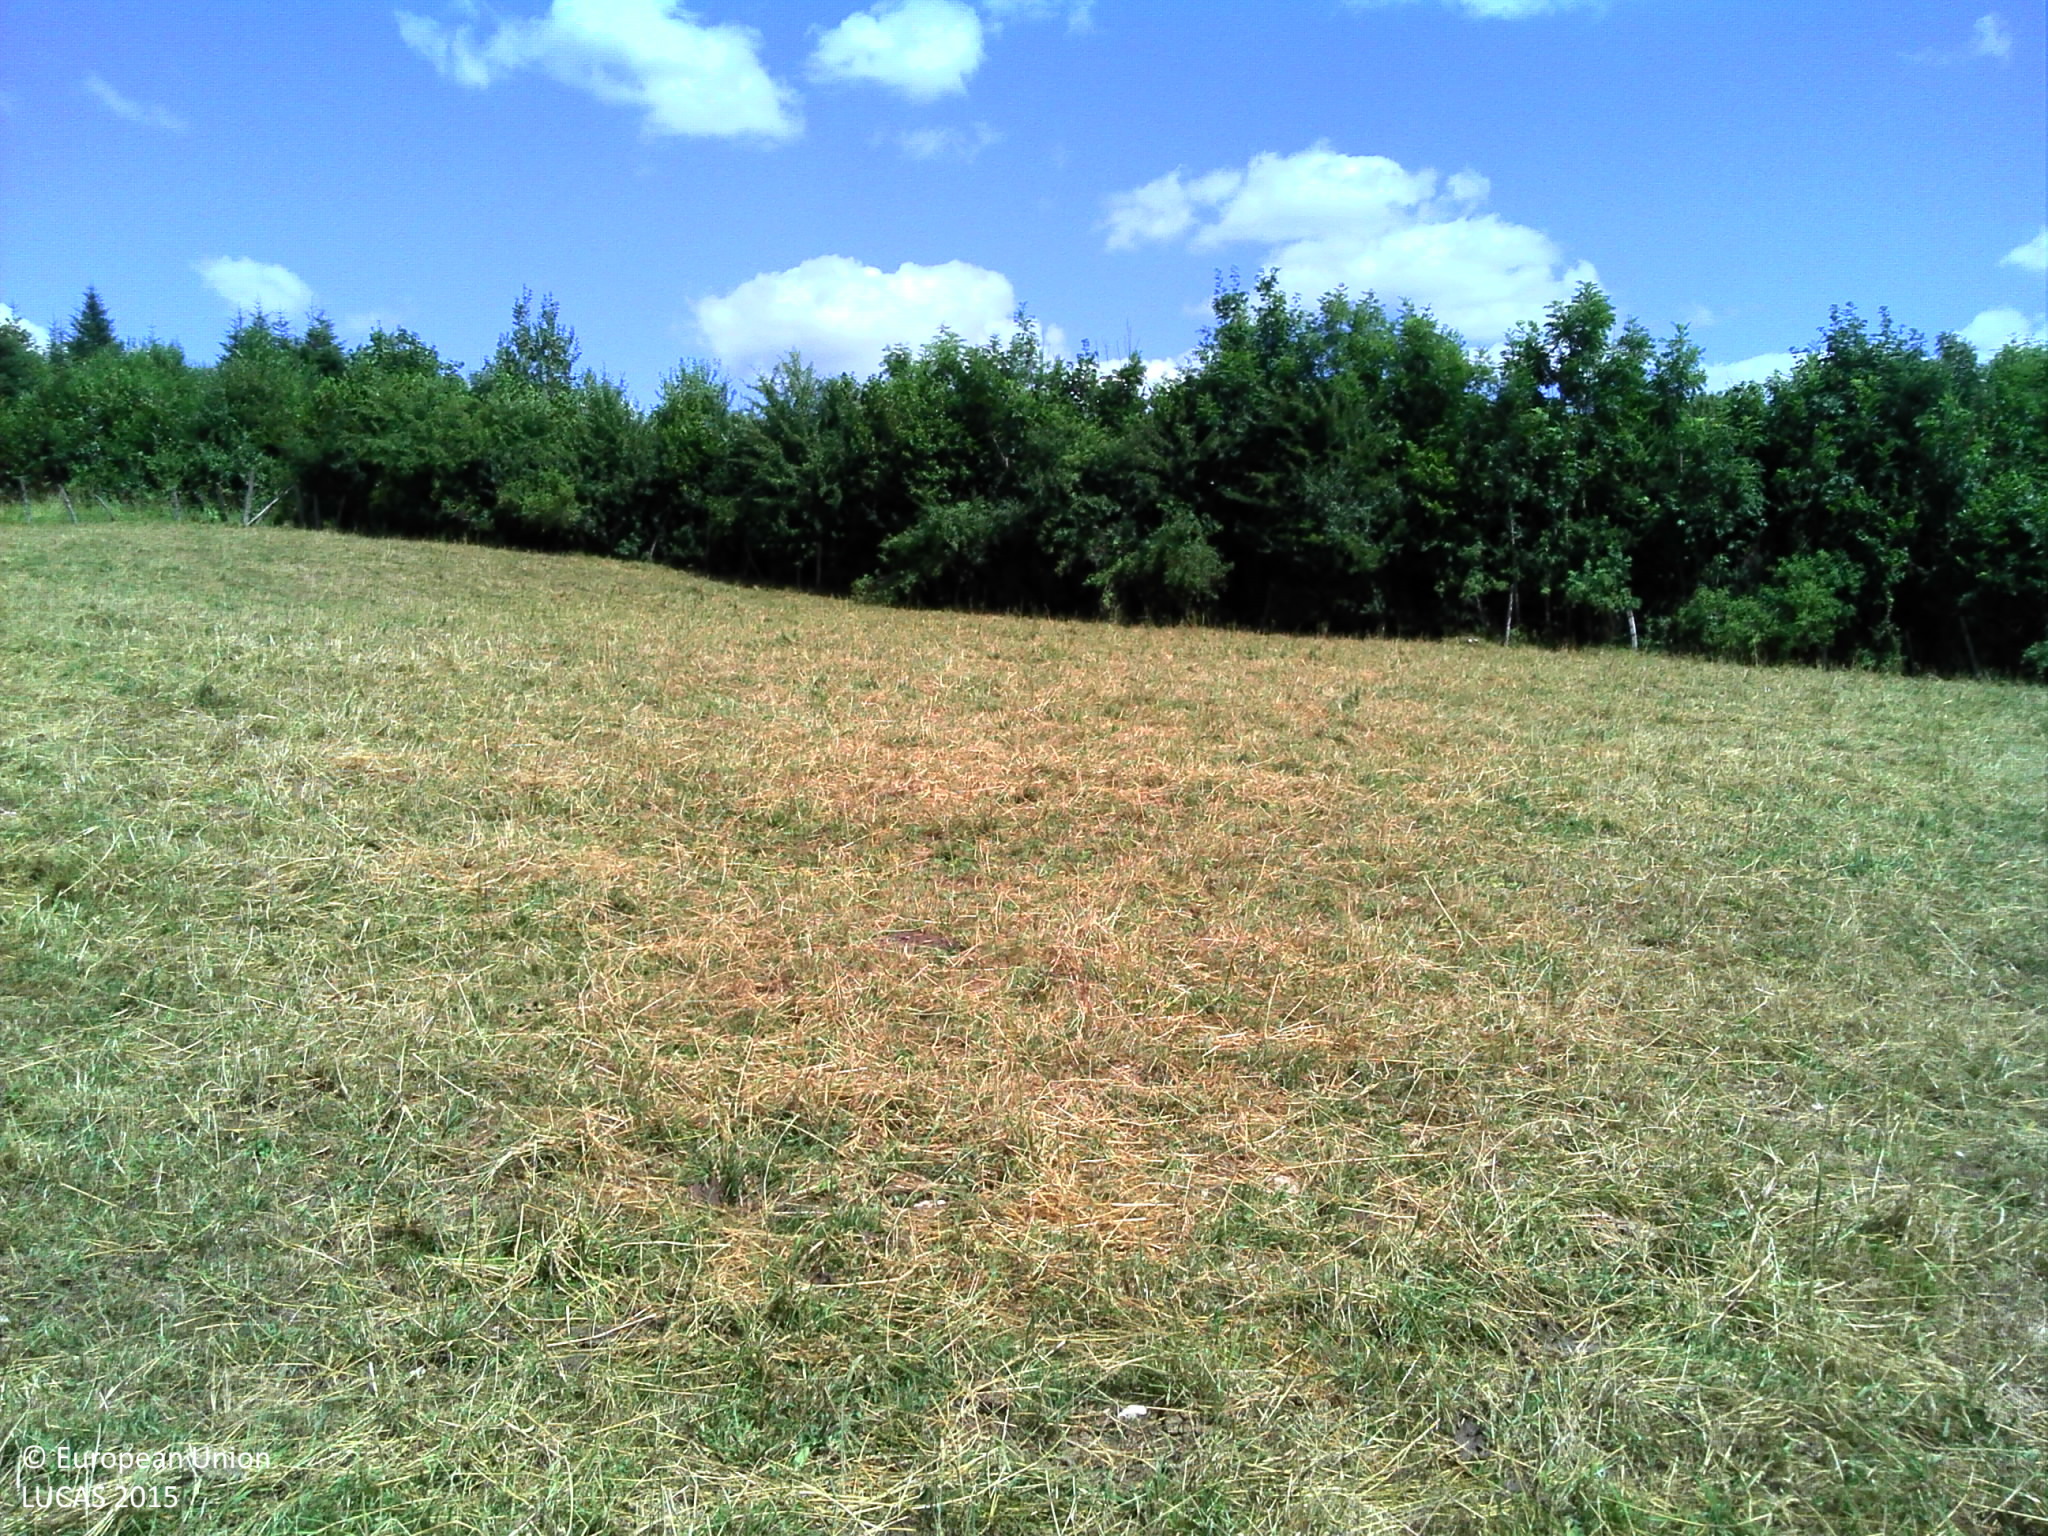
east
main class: Grassland
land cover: Grassland without tree/shrub cover
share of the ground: > 75 %
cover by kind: herbaceous plants 100 %
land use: Agriculture (excluding fallow land and kitchen gardens)
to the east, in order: Grassland without tree/shrub cover; Fences; Broadleaved woodland; Shruby margins; Paved roads, cycling and walking lanes; Grass margins; Fences; Grassland without tree/shrub cover; Fences; Broadleaved woodland; Grassland without tree/shrub cover
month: July
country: FR
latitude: 46.8374
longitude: 6.0558
